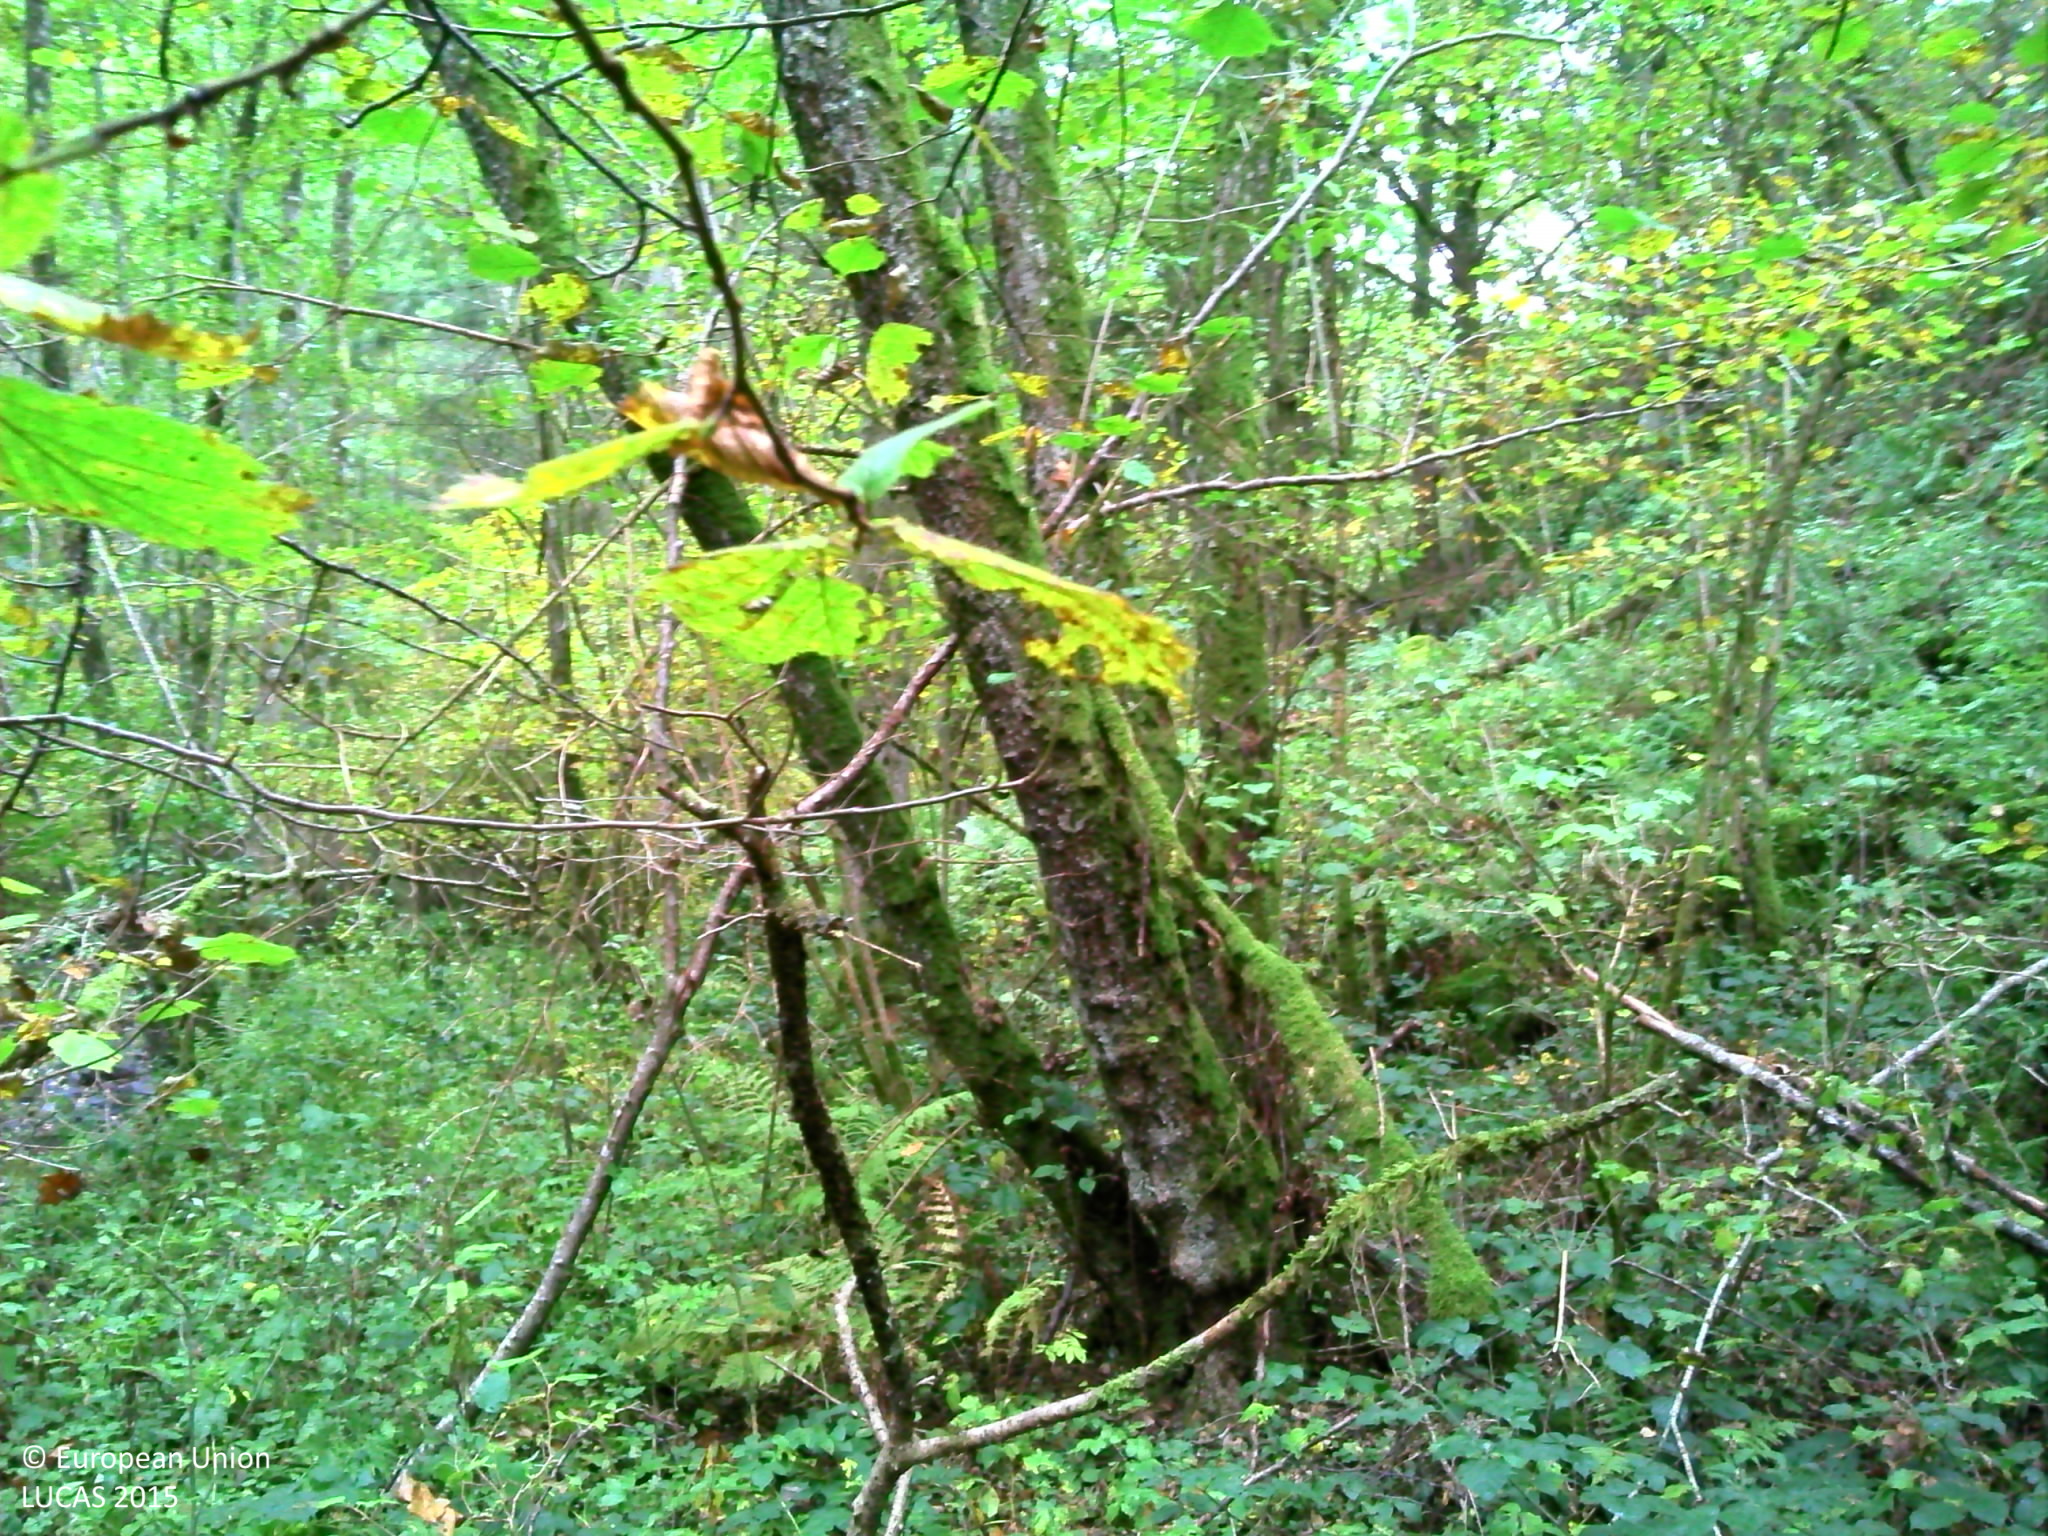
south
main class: Woodland
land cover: Broadleaved woodland
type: mesophytic deciduous forest
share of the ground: > 75 %
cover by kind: broadleaved forest trees 80 %, herbaceous plants 10 %, coniferous forest trees 5 %, shrubs 5 %
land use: Forestry
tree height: > 5 m
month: October
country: FR
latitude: 45.9986
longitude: 2.7800
